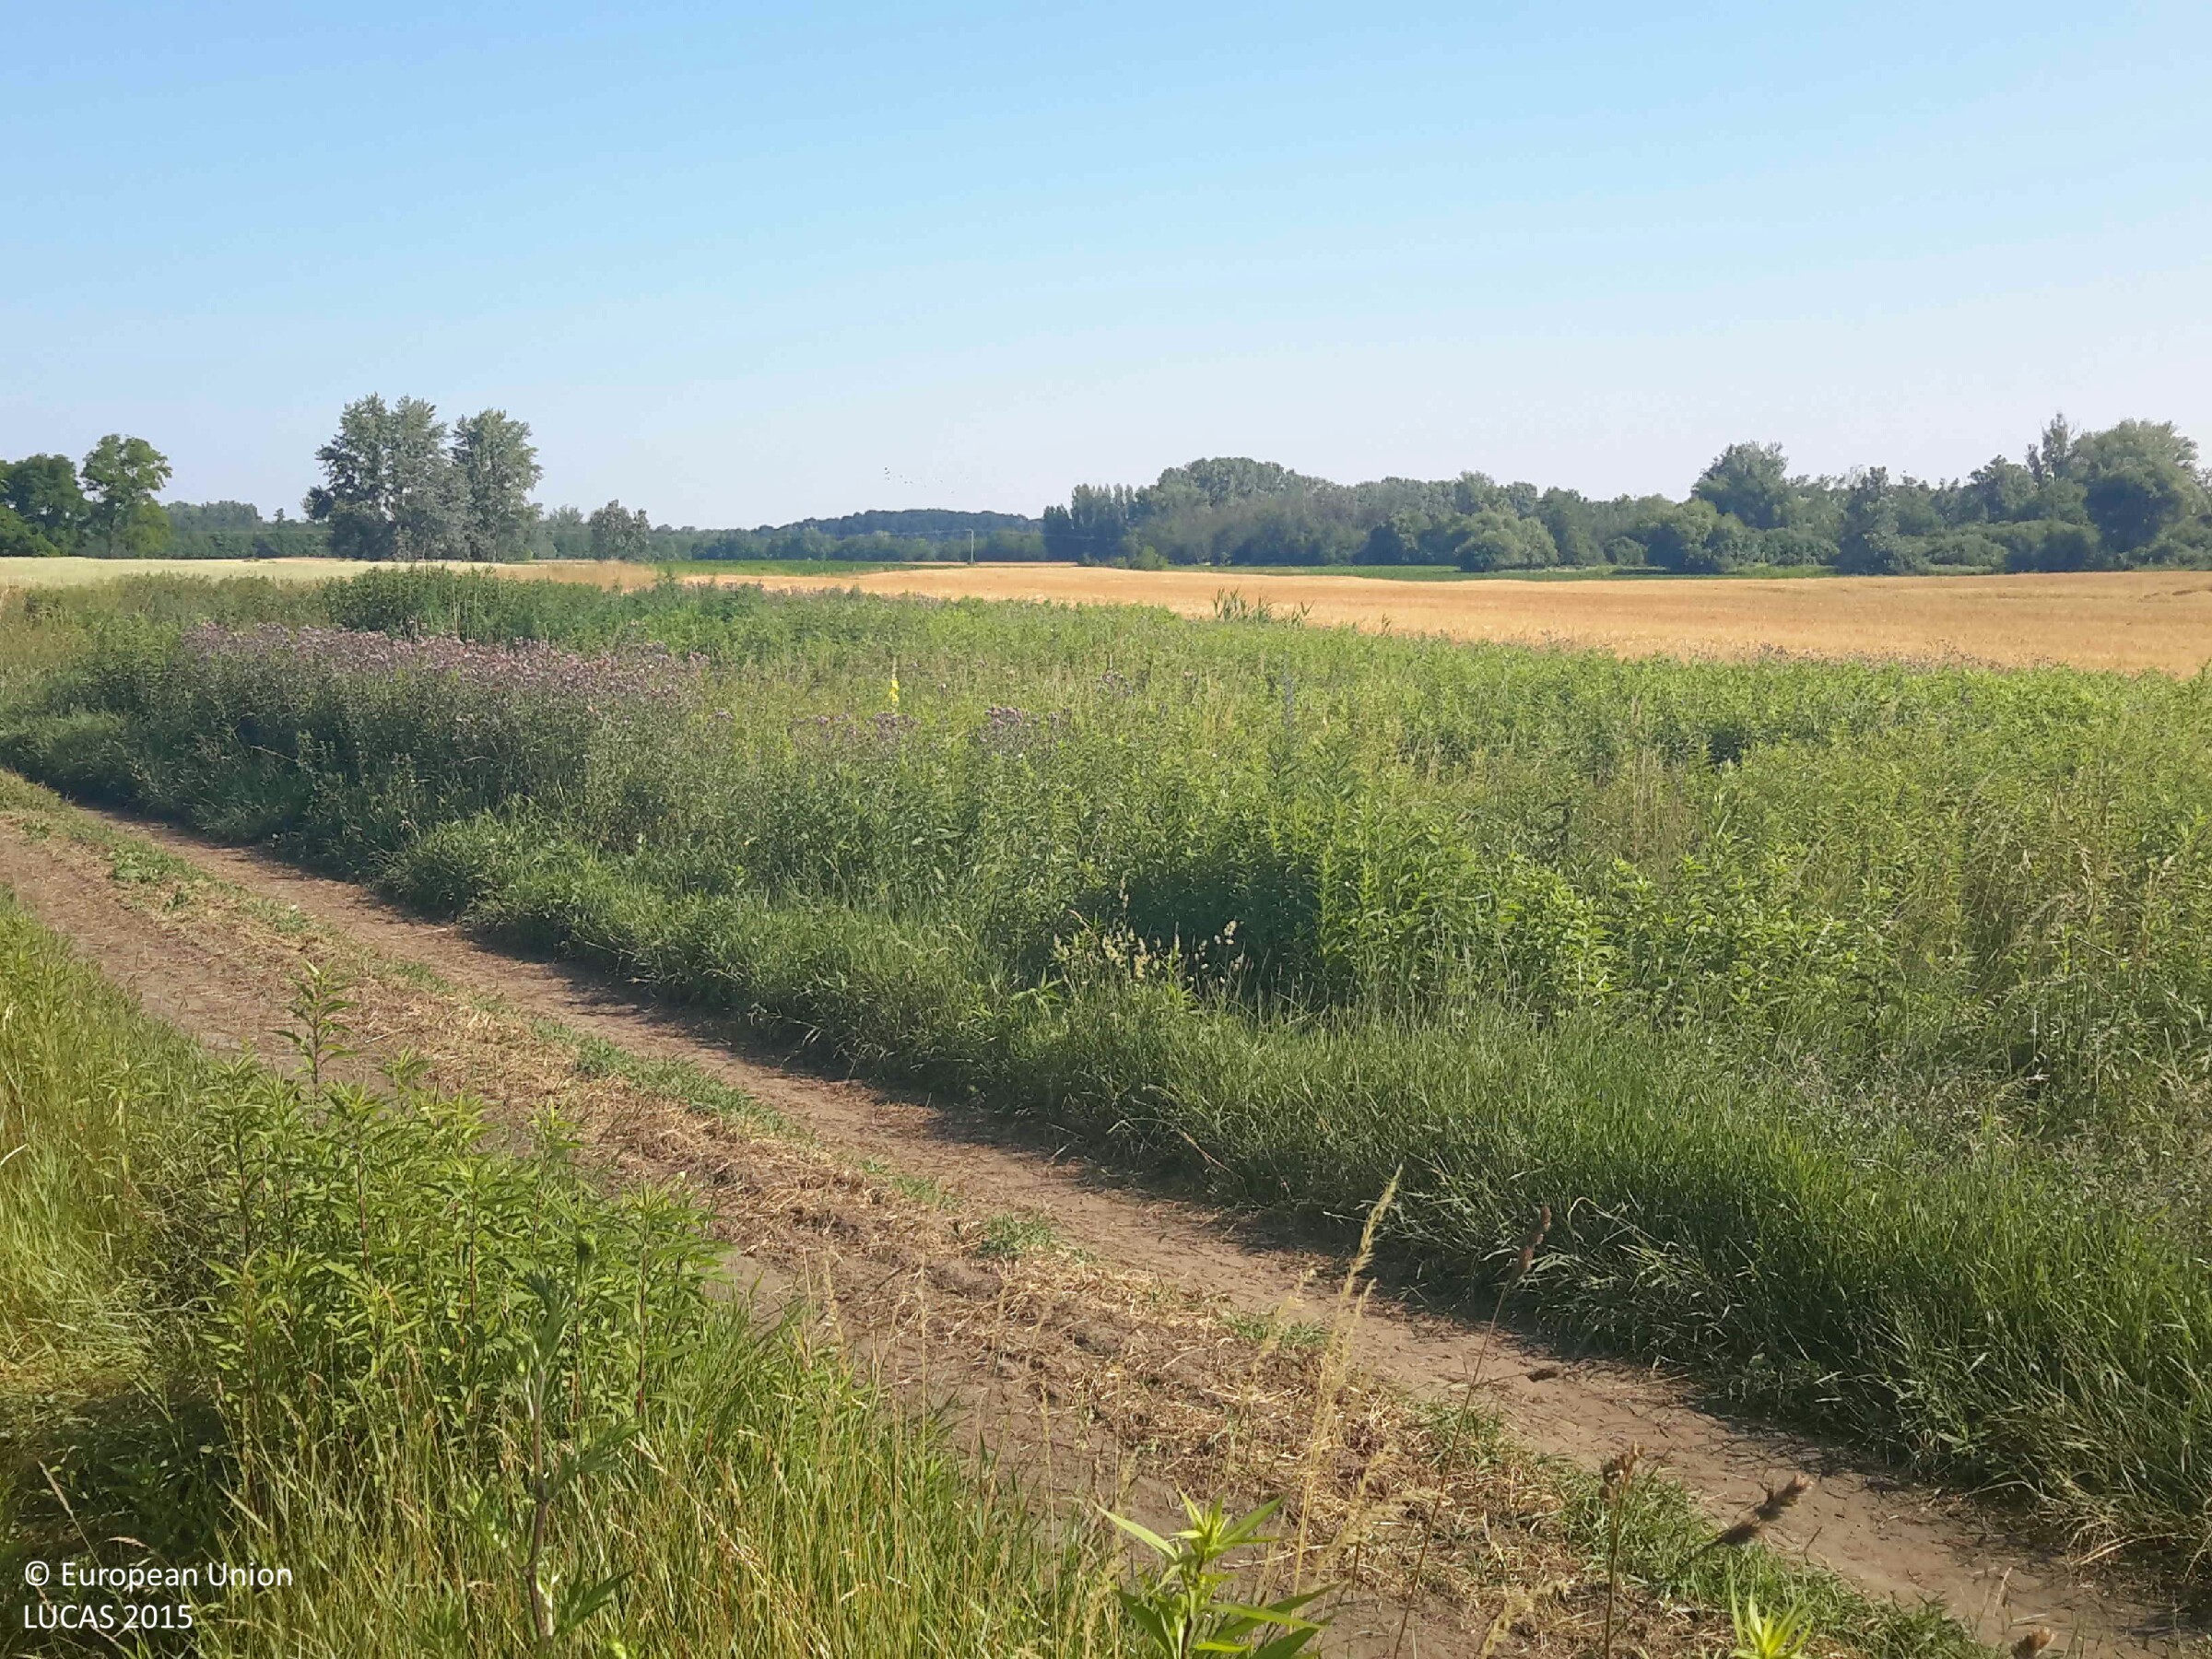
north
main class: Grassland
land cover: Spontaneously vegetated surfaces
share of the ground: > 75 %
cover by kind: herbaceous plants 100 %
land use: Abandoned areas
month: June
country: HU
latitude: 47.6693
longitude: 17.3727
